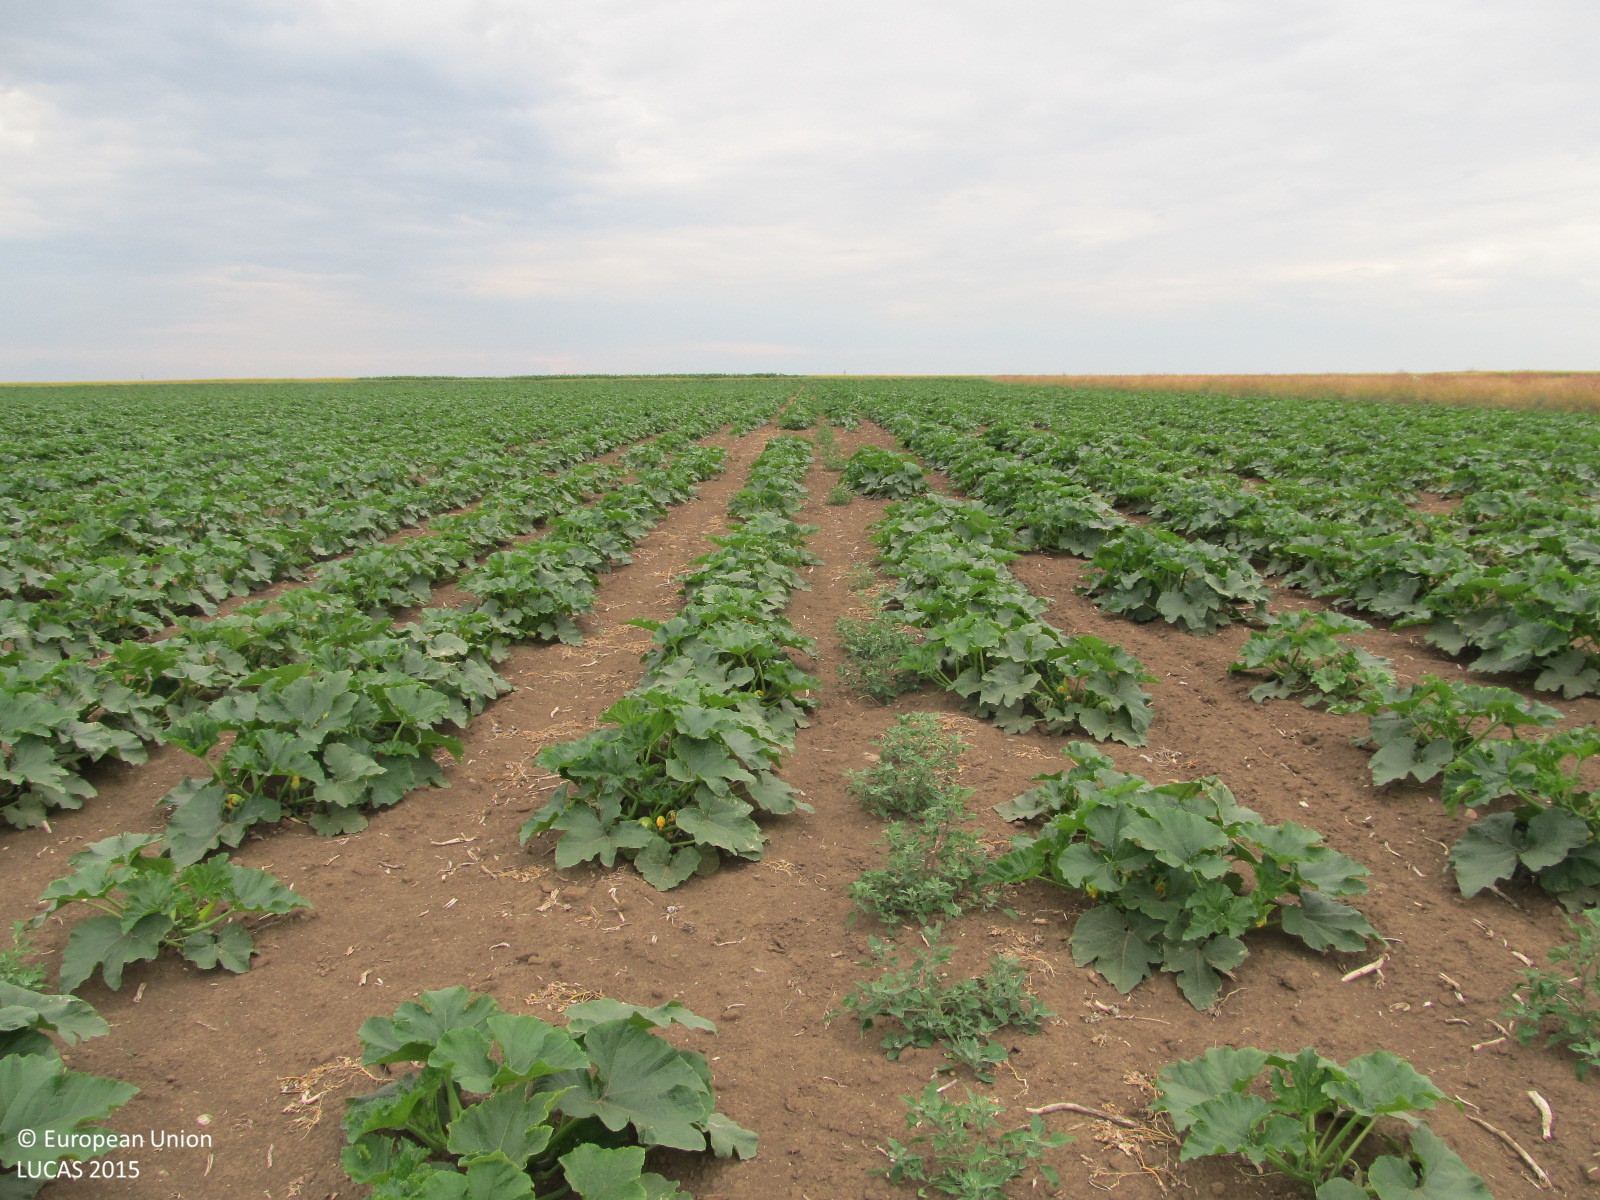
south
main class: Cropland
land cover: Other fibre and oleaginous crops
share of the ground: 25 - 50 %
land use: Agriculture (excluding fallow land and kitchen gardens)
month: June
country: AT
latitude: 48.6783
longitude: 15.9121
